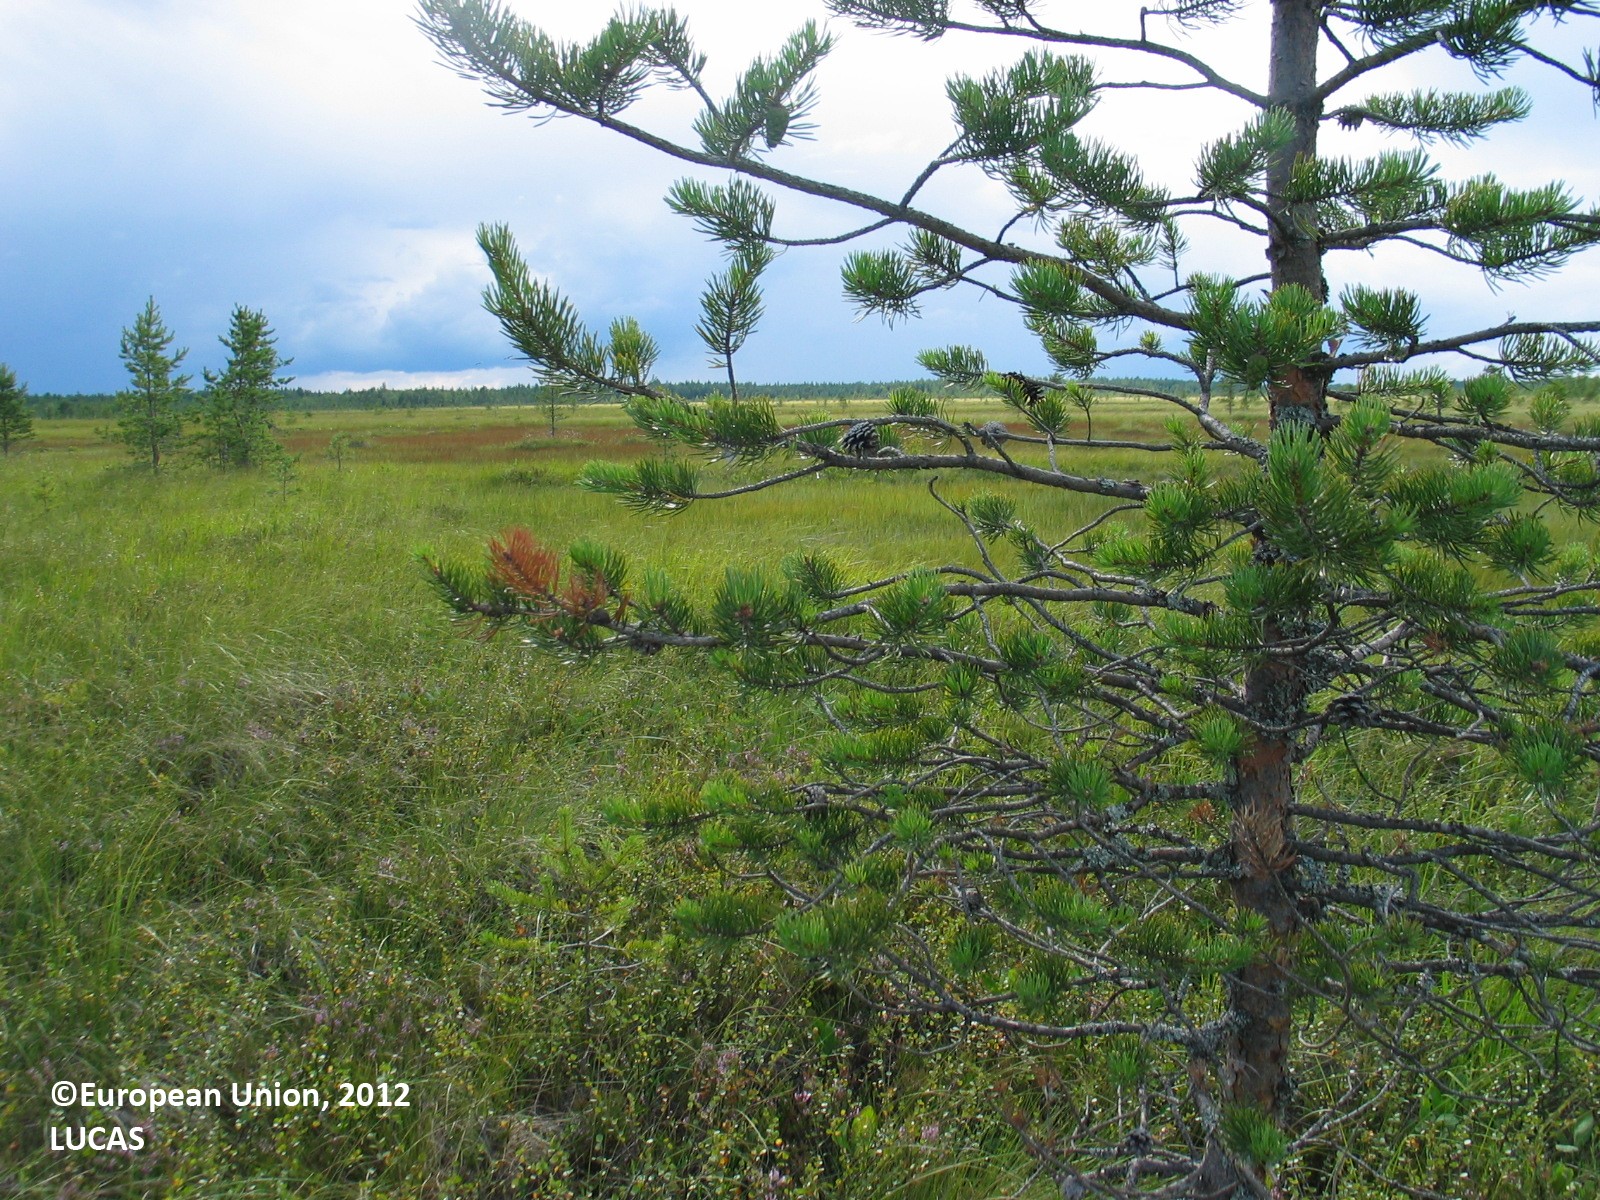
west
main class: Woodland
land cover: Pine dominated coniferous woodland
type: mire and swamp forests
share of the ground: 10 - 25 %
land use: Semi-natural and natural areas not in use
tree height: > 5 m
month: August
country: FI
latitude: 64.6102
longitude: 26.0504
